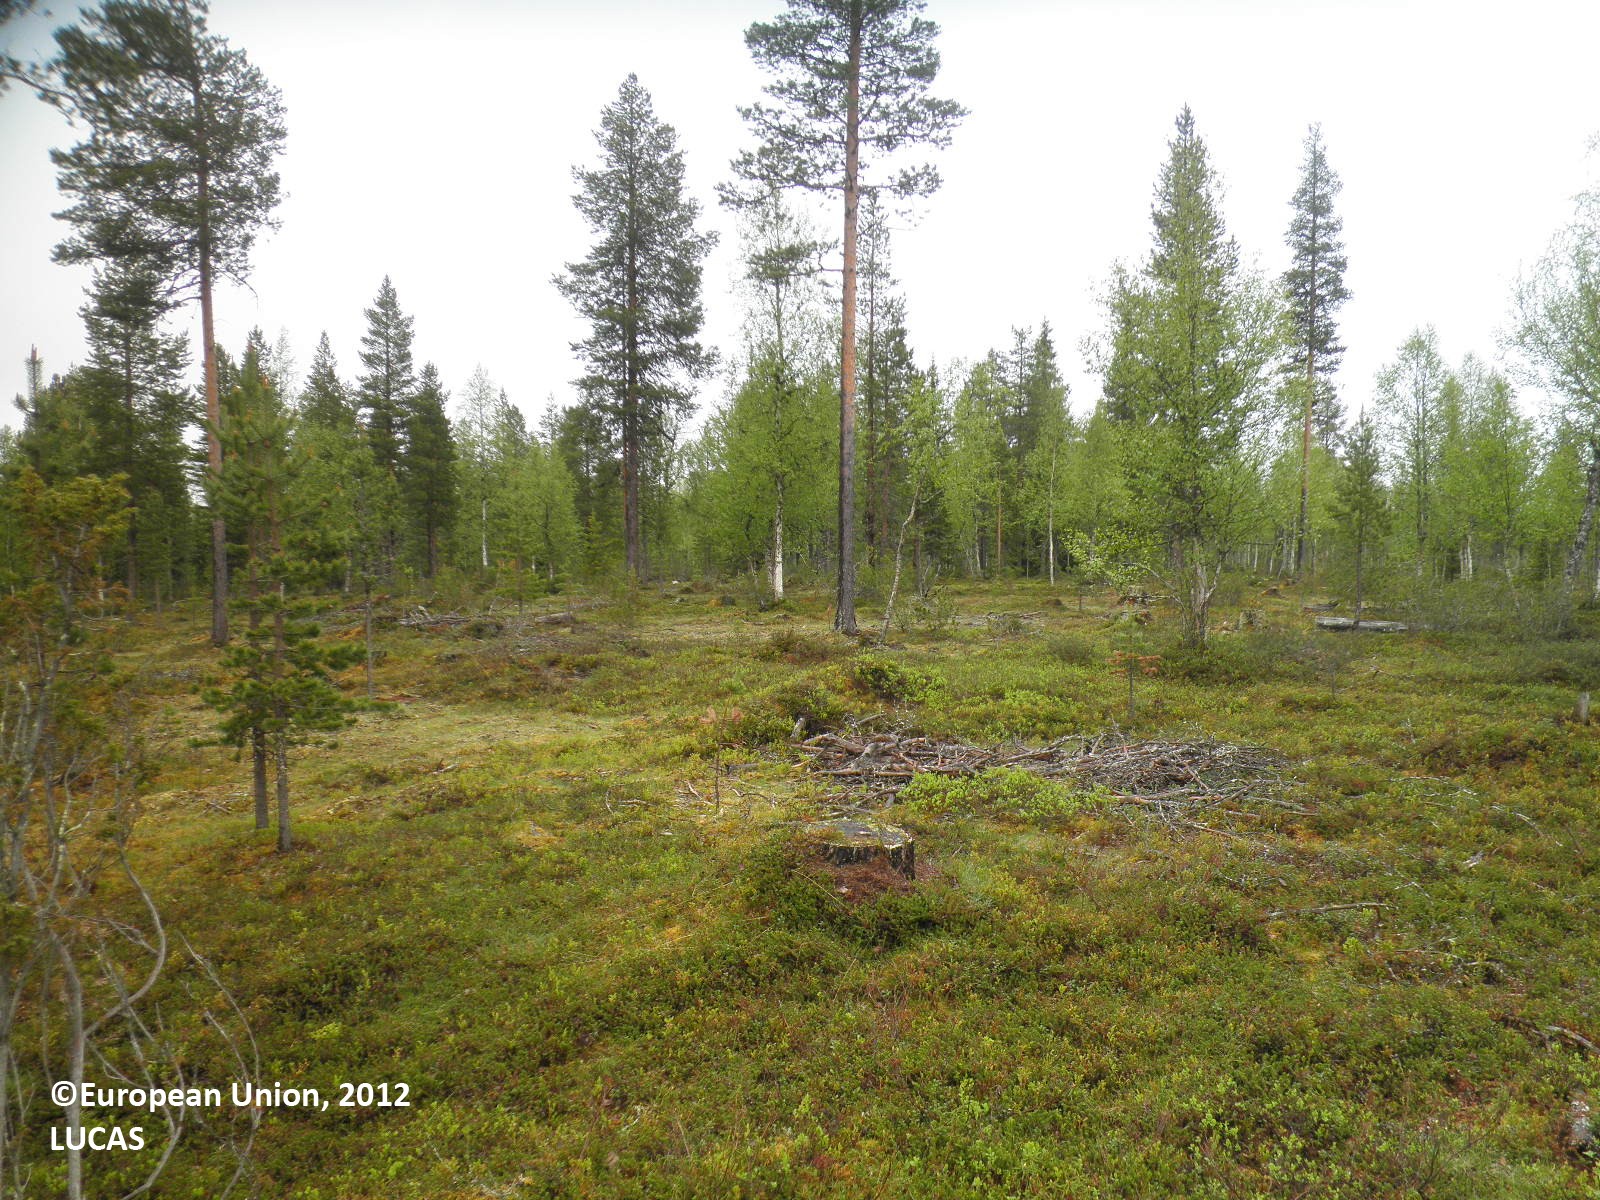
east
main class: Woodland
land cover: Pine dominated mixed woodland
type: boreal forest
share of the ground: 10 - 25 %
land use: Forestry
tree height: > 5 m
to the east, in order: Pine dominated mixed woodland; Broadleaved woodland
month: June
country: FI
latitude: 68.1110
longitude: 25.5435
